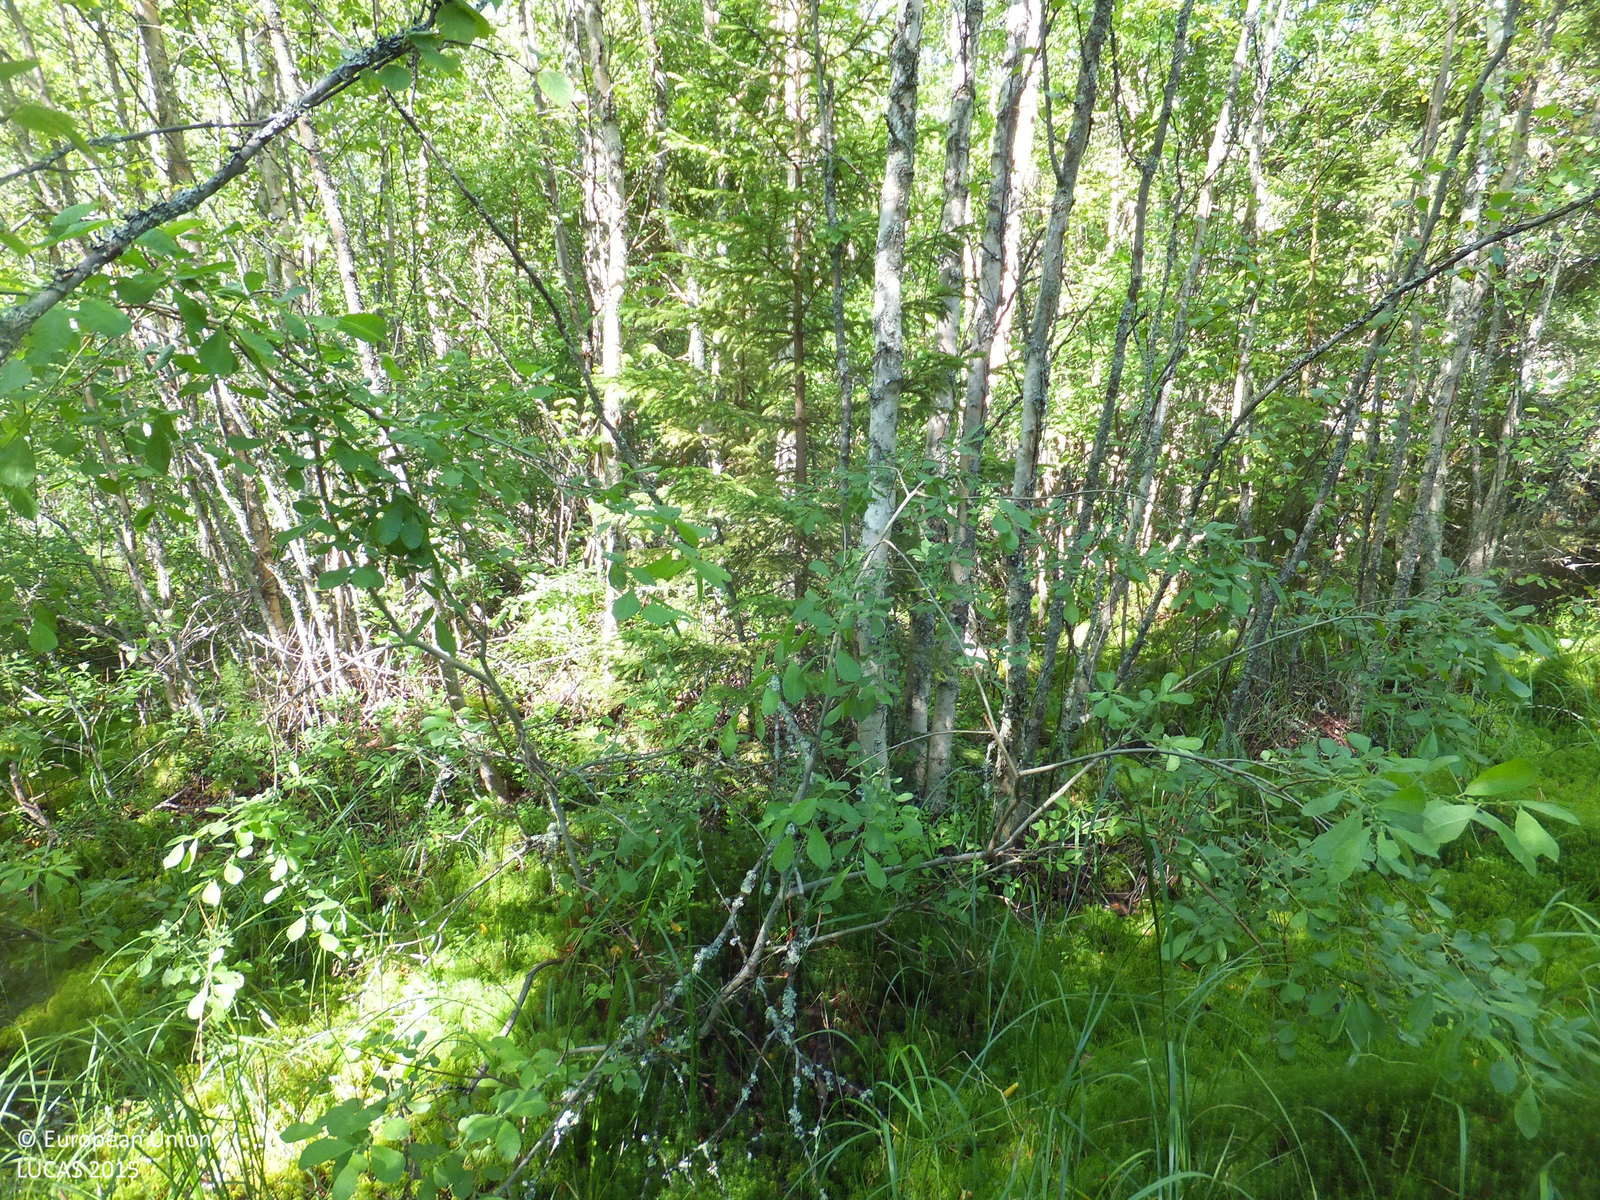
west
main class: Woodland
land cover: Broadleaved woodland
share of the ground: 50 - 75 %
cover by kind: broadleaved forest trees 60 %, lichens and mosses 20 %, herbaceous plants 10 %, coniferous forest trees 5 %, shrubs 5 %
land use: Forestry
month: July
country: FI
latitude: 63.1984
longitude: 21.6688
